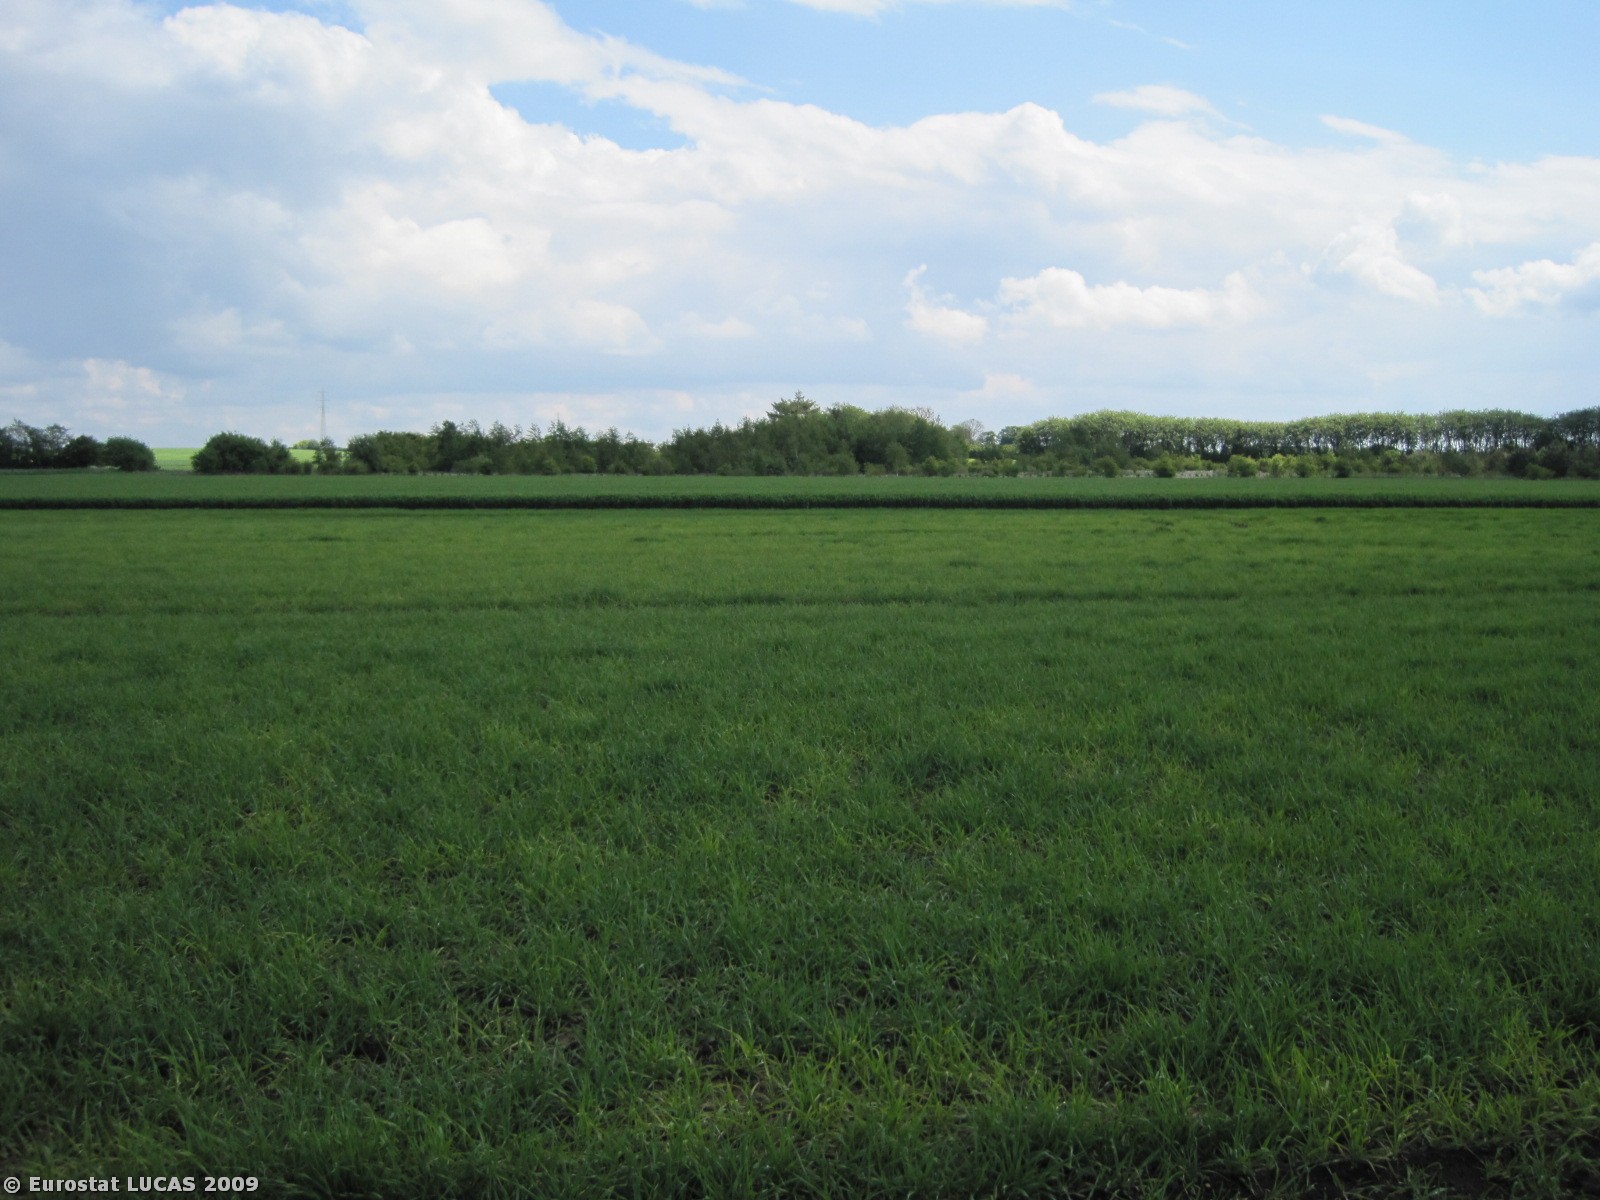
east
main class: Cropland
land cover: Barley
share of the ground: > 75 %
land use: Agriculture (excluding fallow land and kitchen gardens)
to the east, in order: Barley; Grassland with sparse tree/shrub cover; Broadleaved woodland; Grassland with sparse tree/shrub cover
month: May
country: DK
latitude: 56.3492
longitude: 9.6929
